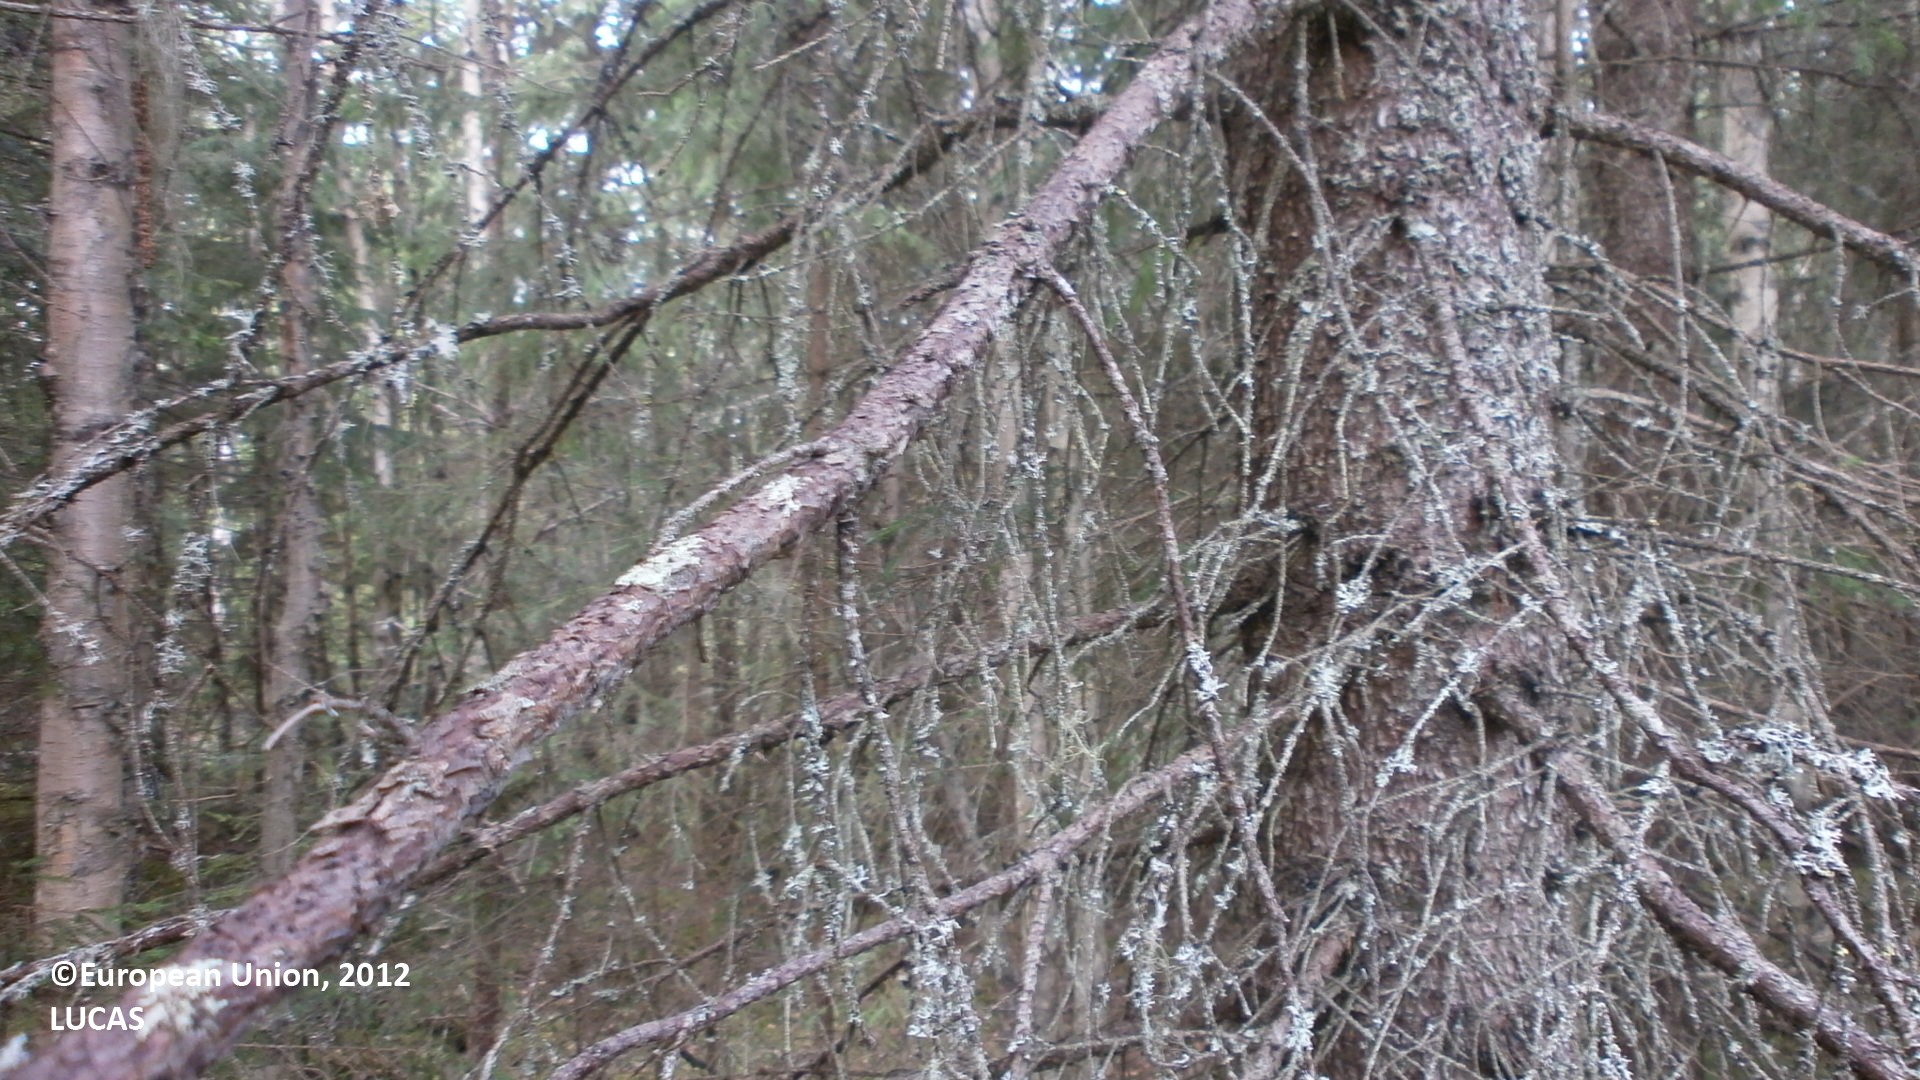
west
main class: Woodland
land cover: Spruce dominated mixed woodland
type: boreal forest
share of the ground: > 75 %
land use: Forestry
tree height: > 5 m
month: July
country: FI
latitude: 64.0230
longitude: 24.2920
